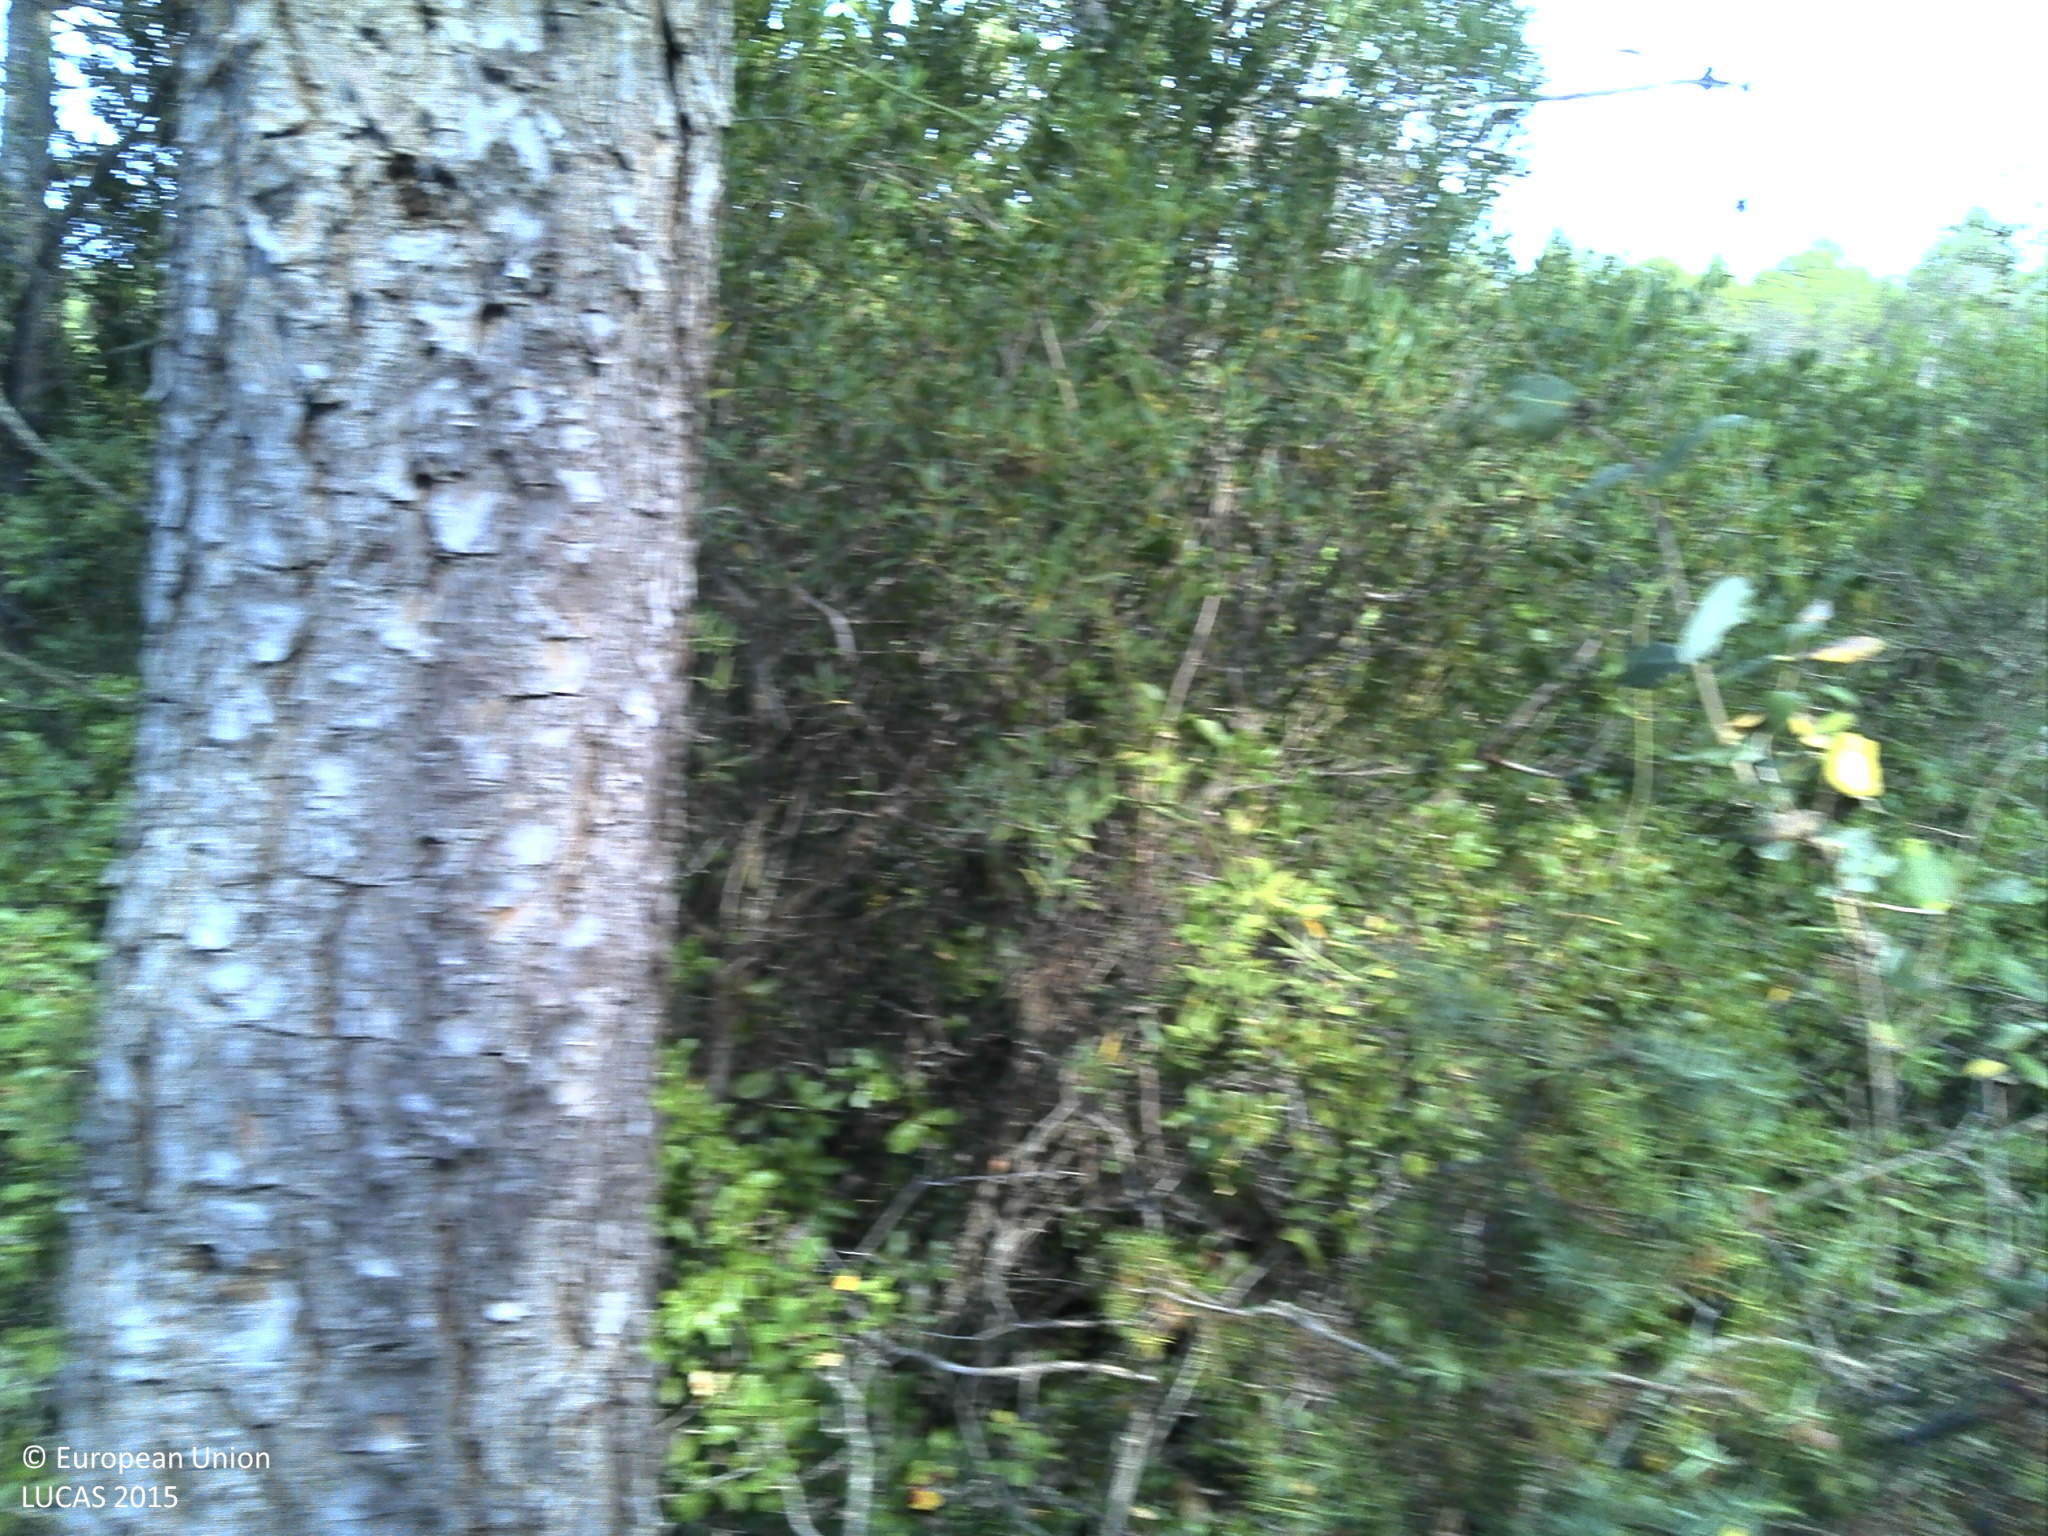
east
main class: Woodland
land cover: Pine dominated mixed woodland
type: coniferous forest of the mediterranean region
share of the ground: > 75 %
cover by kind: coniferous forest trees 50 %, broadleaved forest trees 25 %, herbaceous plants 15 %, unconsolidated bare surface 10 %
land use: Semi-natural and natural areas not in use
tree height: > 5 m
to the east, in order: Pine dominated mixed woodland; Tracks; Pine dominated mixed woodland; Shrubland with sparse tree cover; Pine dominated mixed woodland
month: July
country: FR
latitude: 43.7780
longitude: 3.9827
